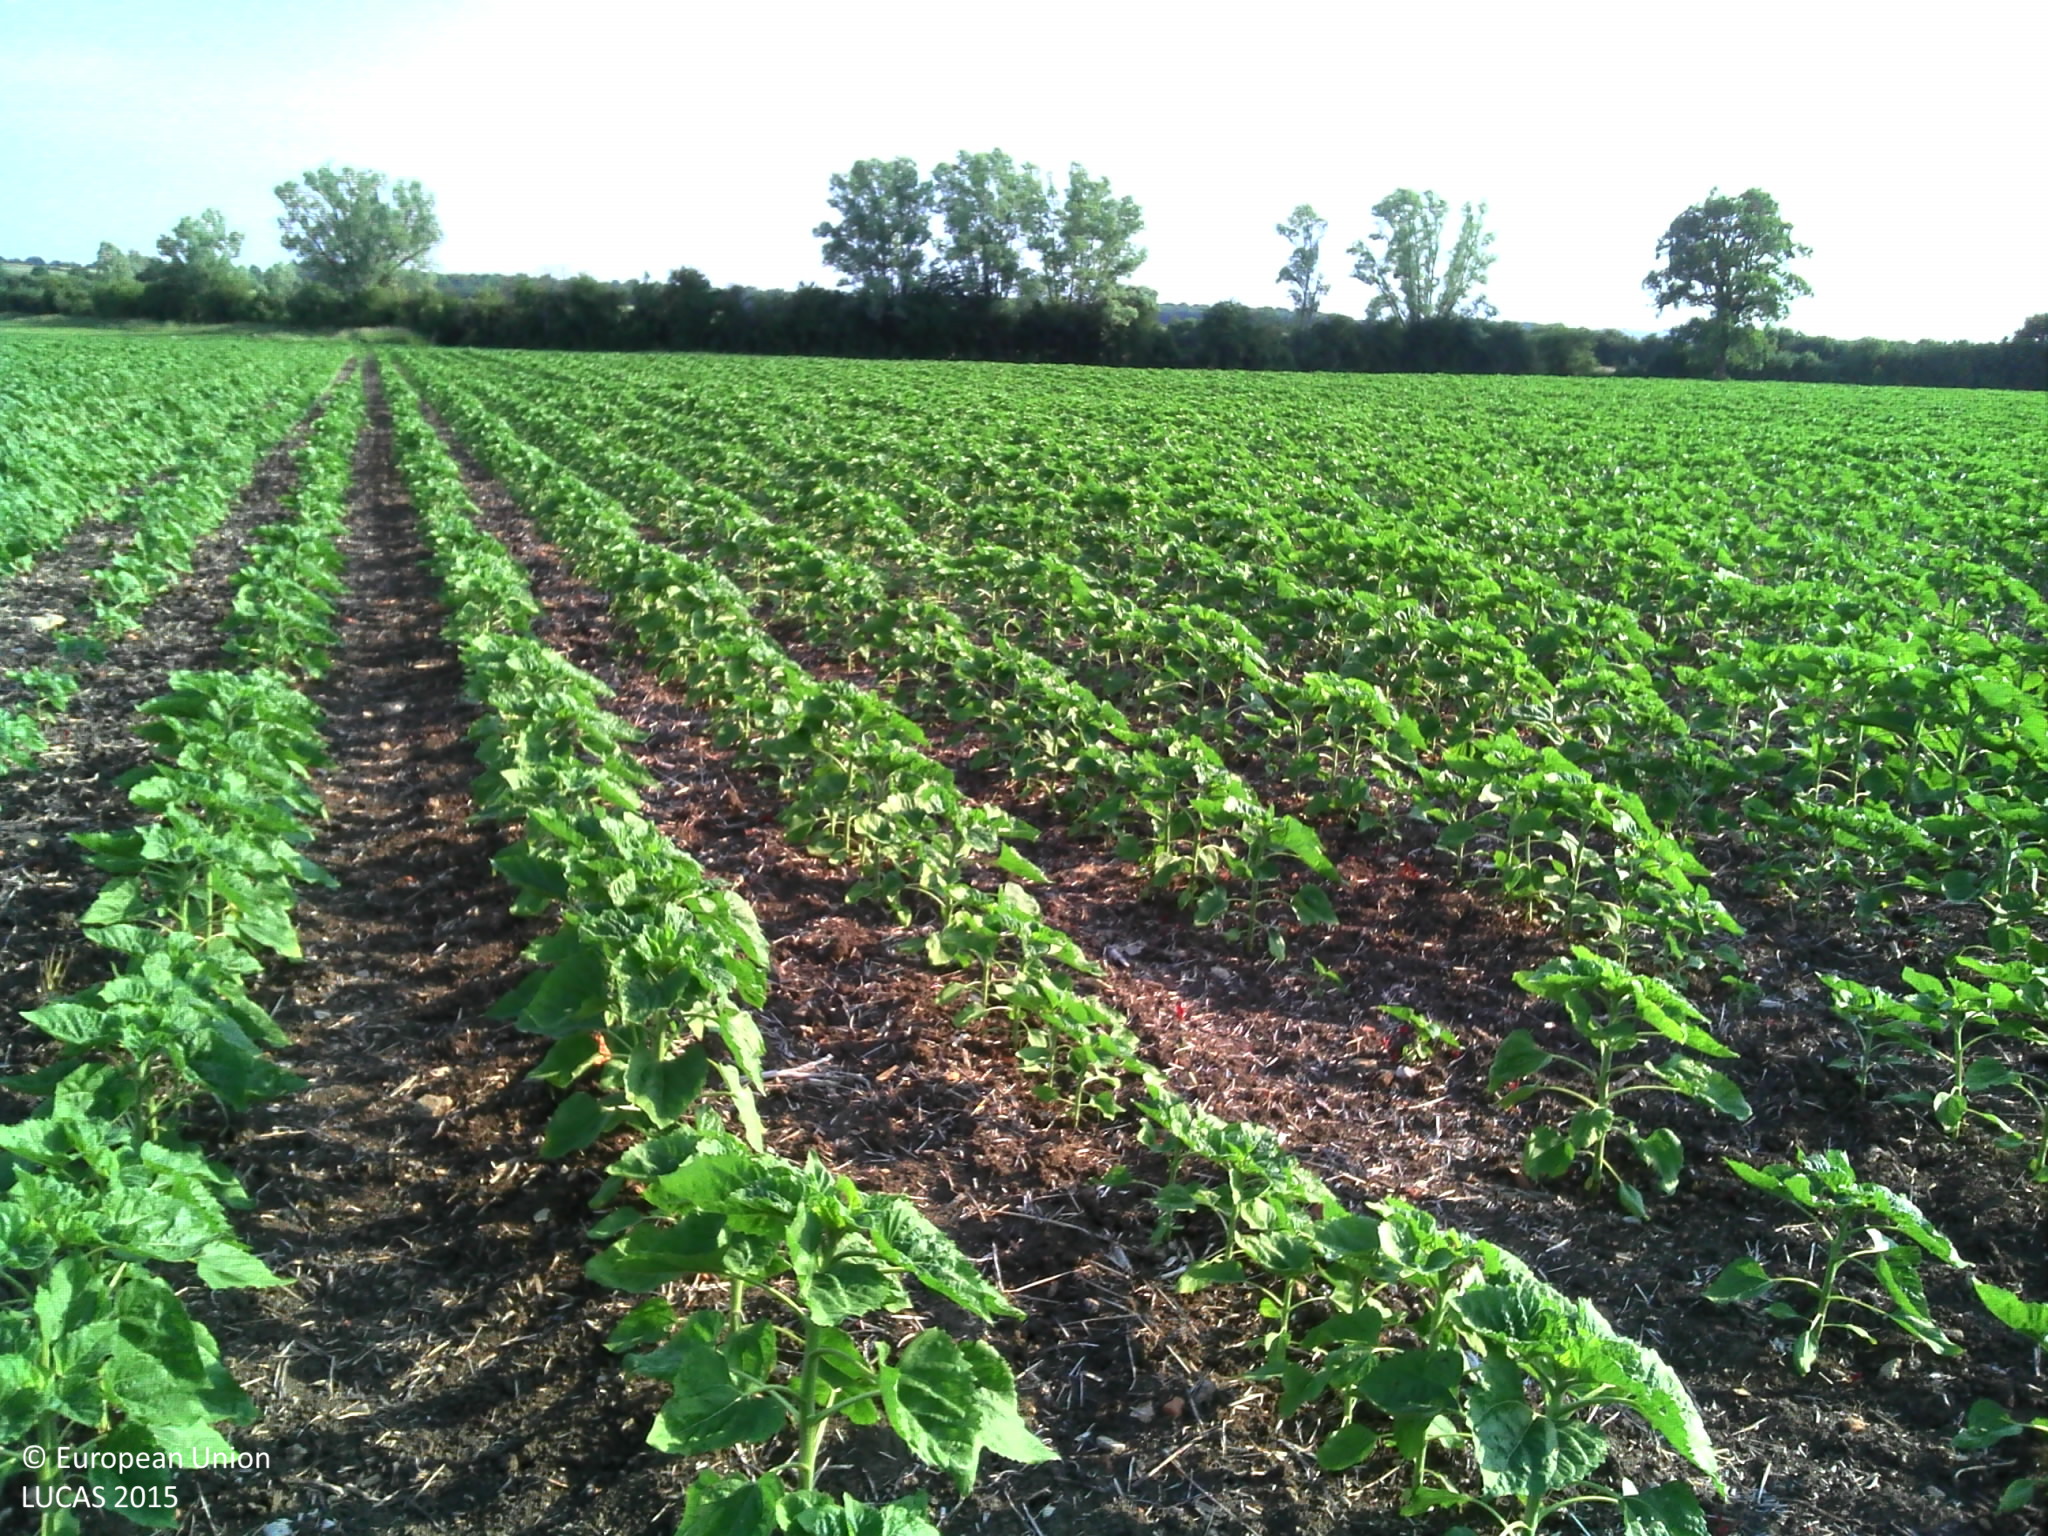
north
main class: Cropland
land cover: Sunflower
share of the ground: > 75 %
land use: Agriculture (excluding fallow land and kitchen gardens)
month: June
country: FR
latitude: 46.8763
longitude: 2.6600
